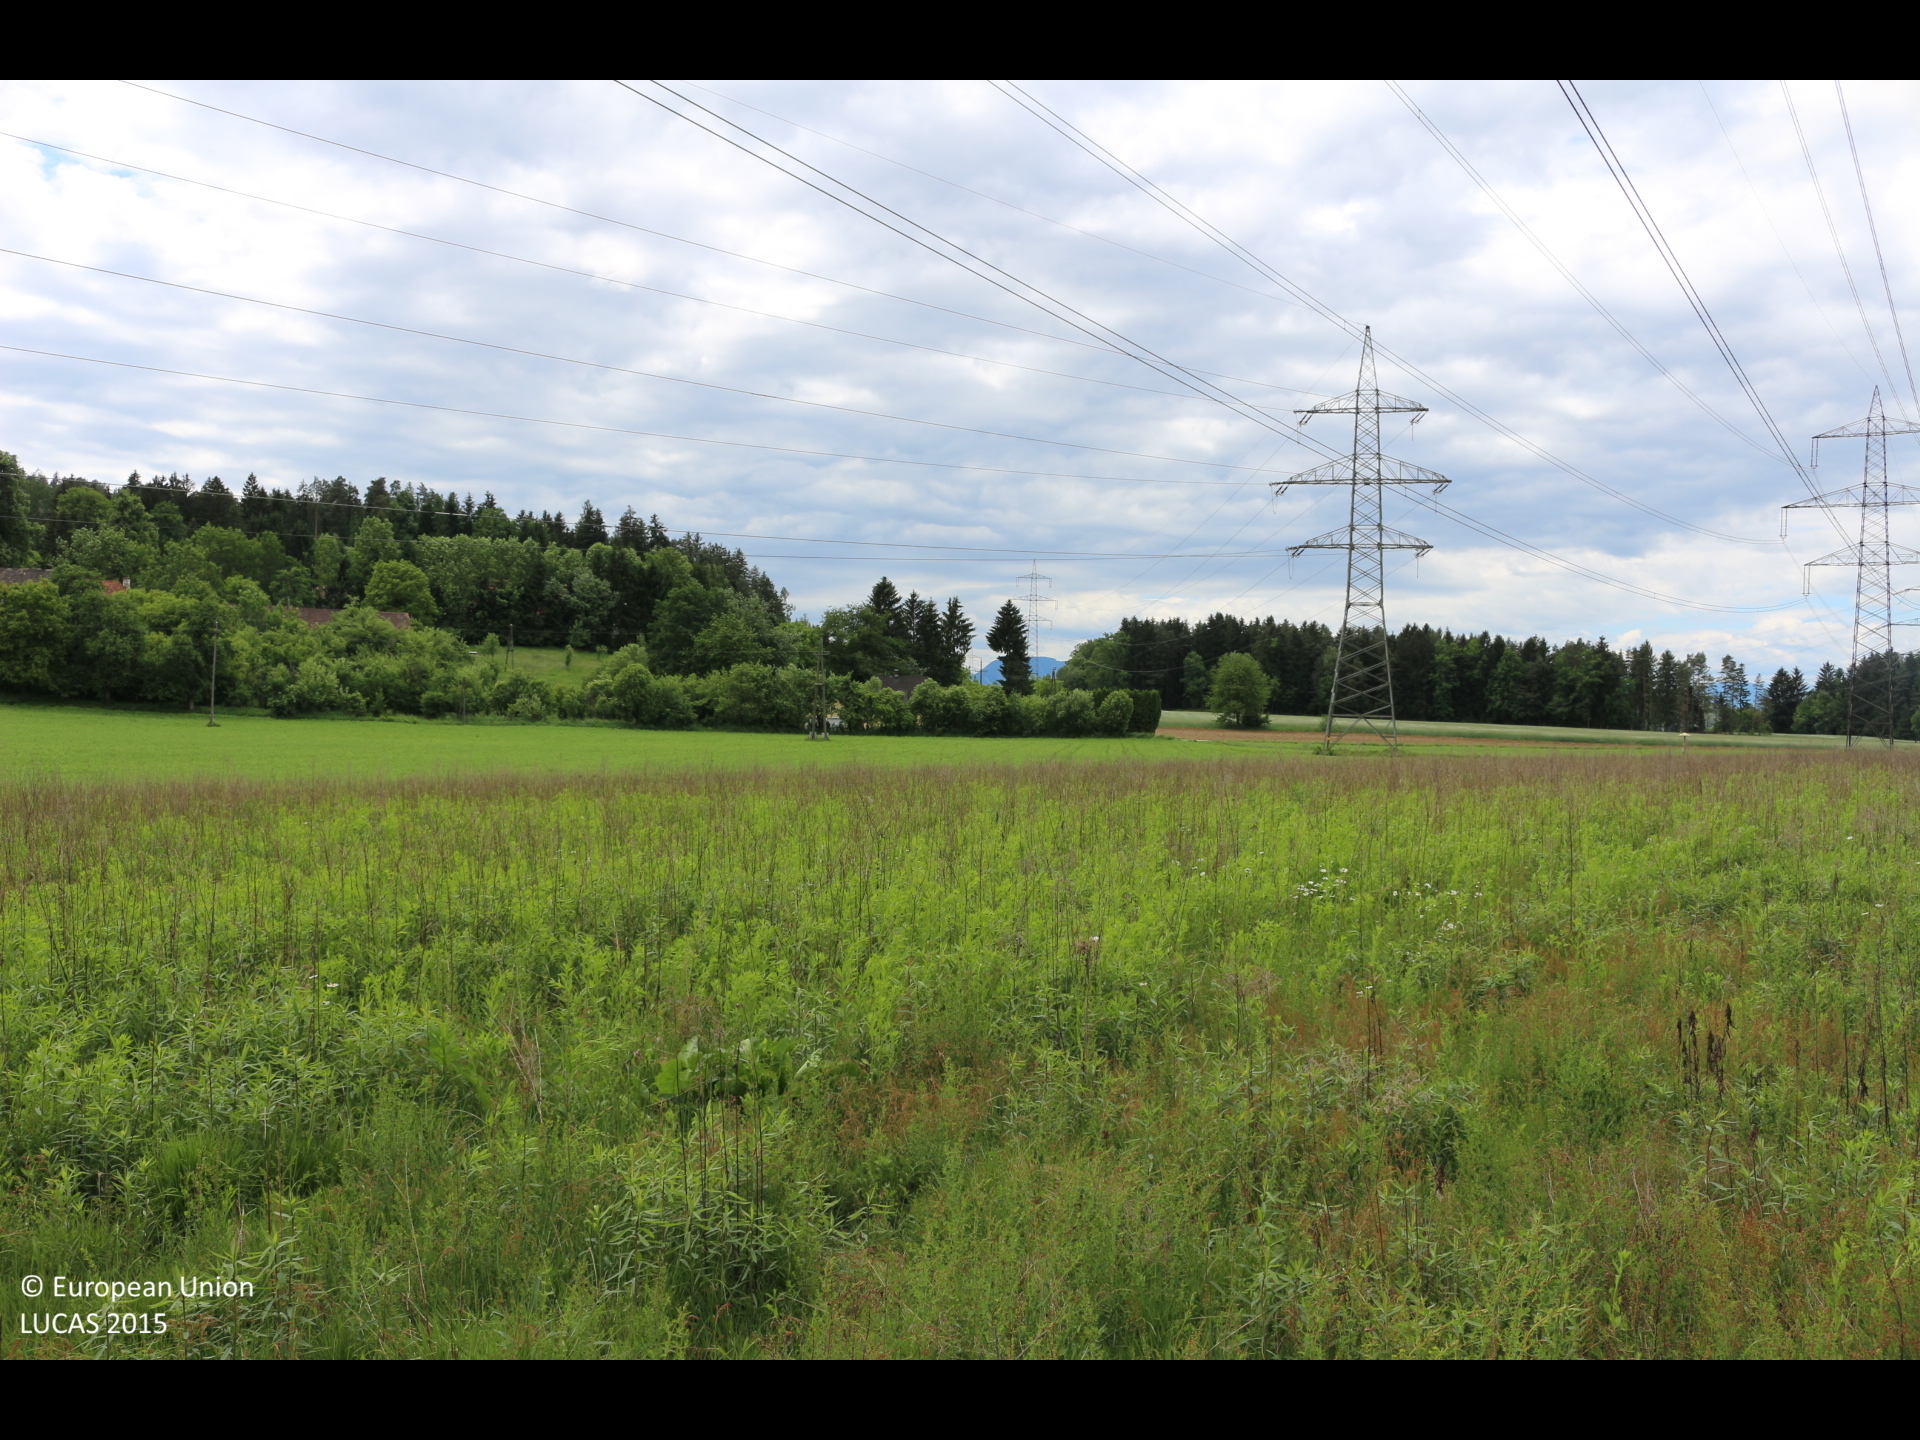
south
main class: Grassland
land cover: Spontaneously vegetated surfaces
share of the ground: > 75 %
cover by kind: herbaceous plants 100 %
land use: Fallow land
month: May
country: AT
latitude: 46.6813
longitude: 14.6914
